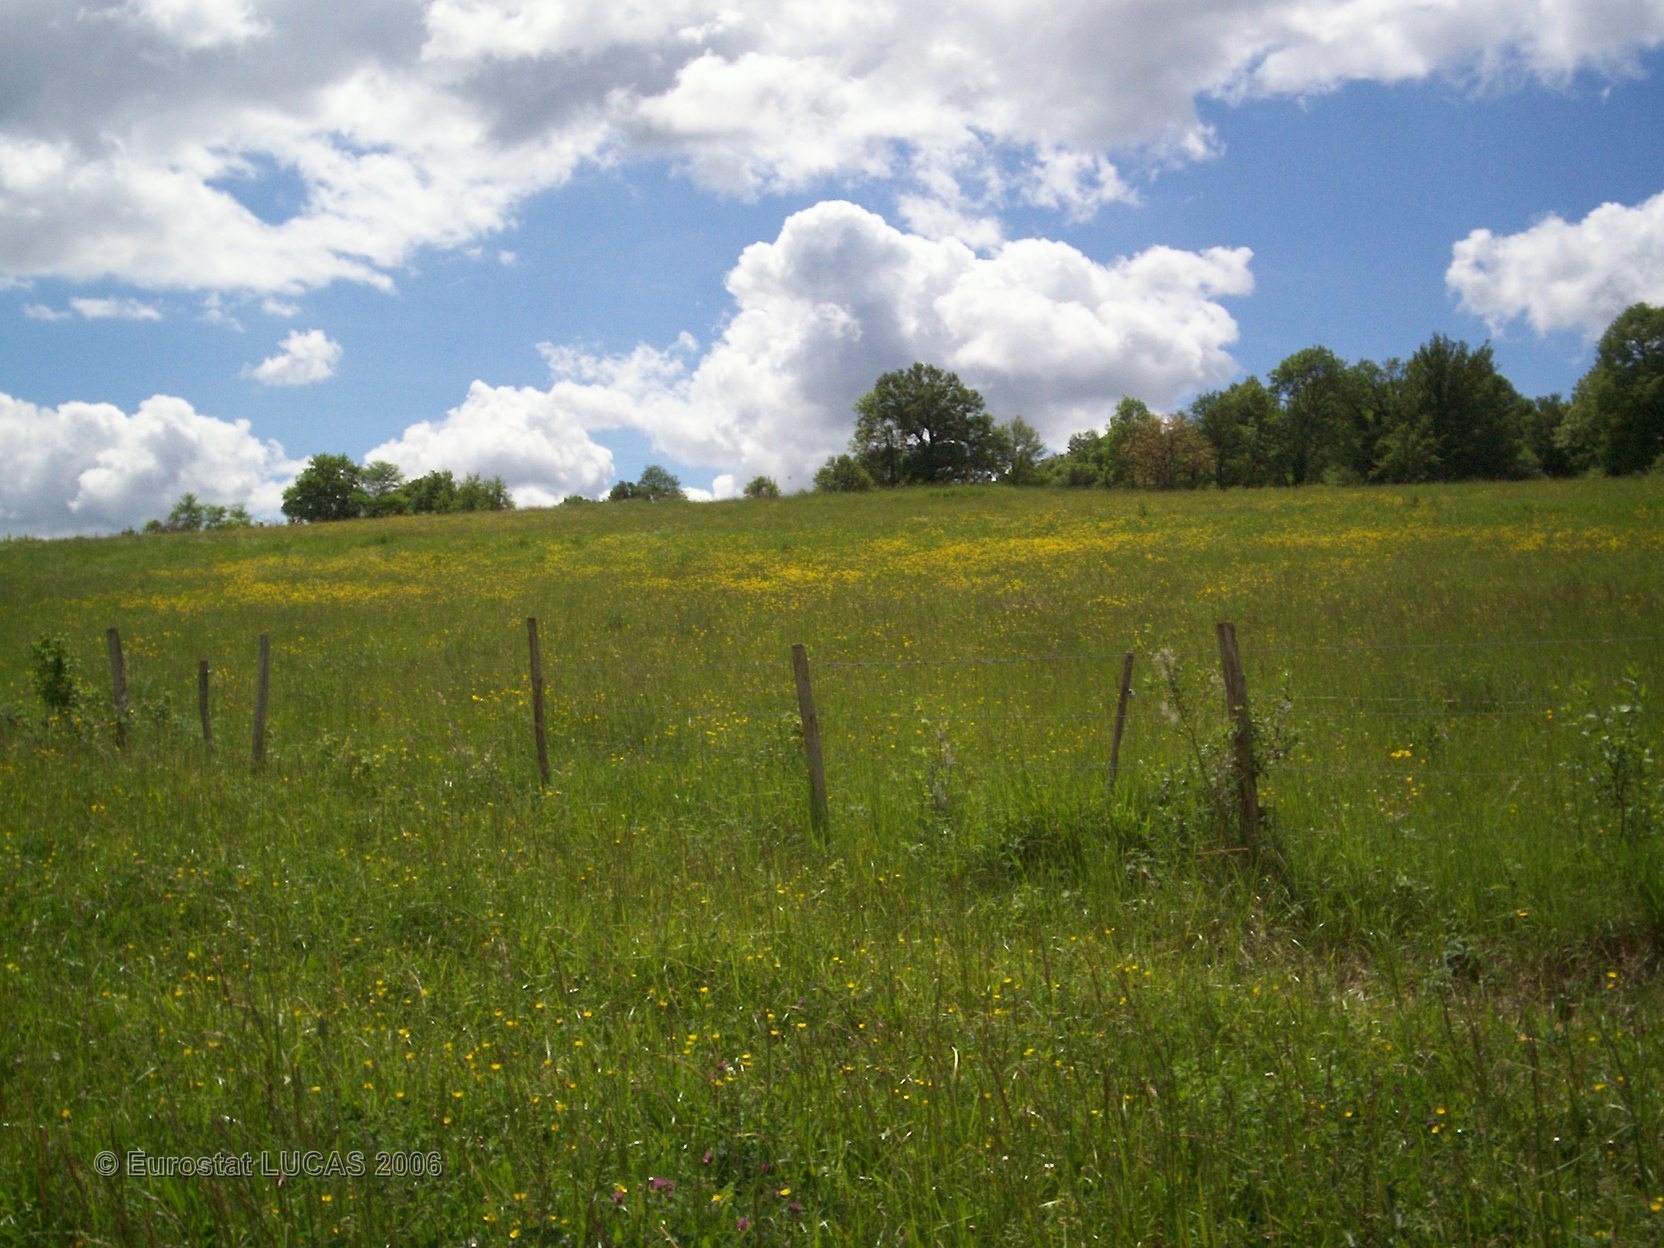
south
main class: Grassland
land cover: Grassland without tree/shrub cover
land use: Agriculture (excluding fallow land and kitchen gardens)
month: May
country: FR
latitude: 44.8996
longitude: 1.8553
